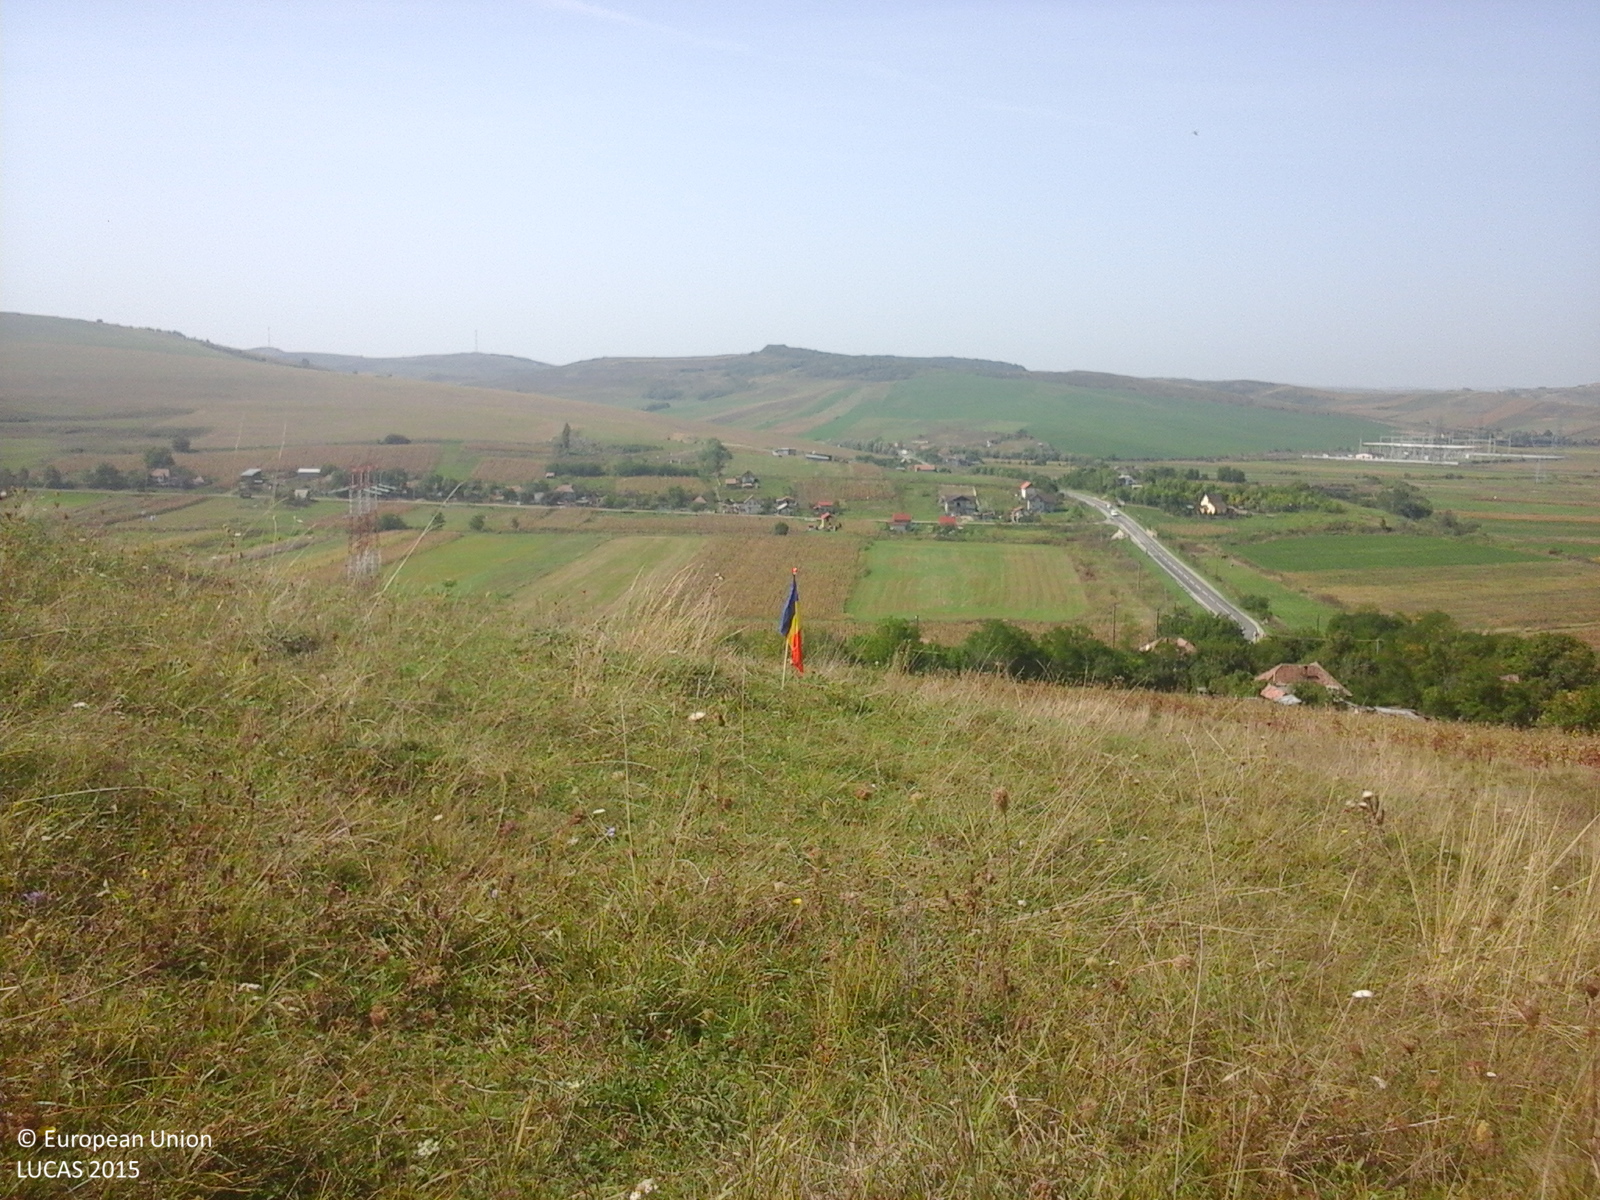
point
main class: Grassland
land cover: Grassland without tree/shrub cover
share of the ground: > 75 %
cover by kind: herbaceous plants 100 %
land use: Agriculture (excluding fallow land and kitchen gardens)
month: September
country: RO
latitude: 46.8111
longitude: 23.8762
